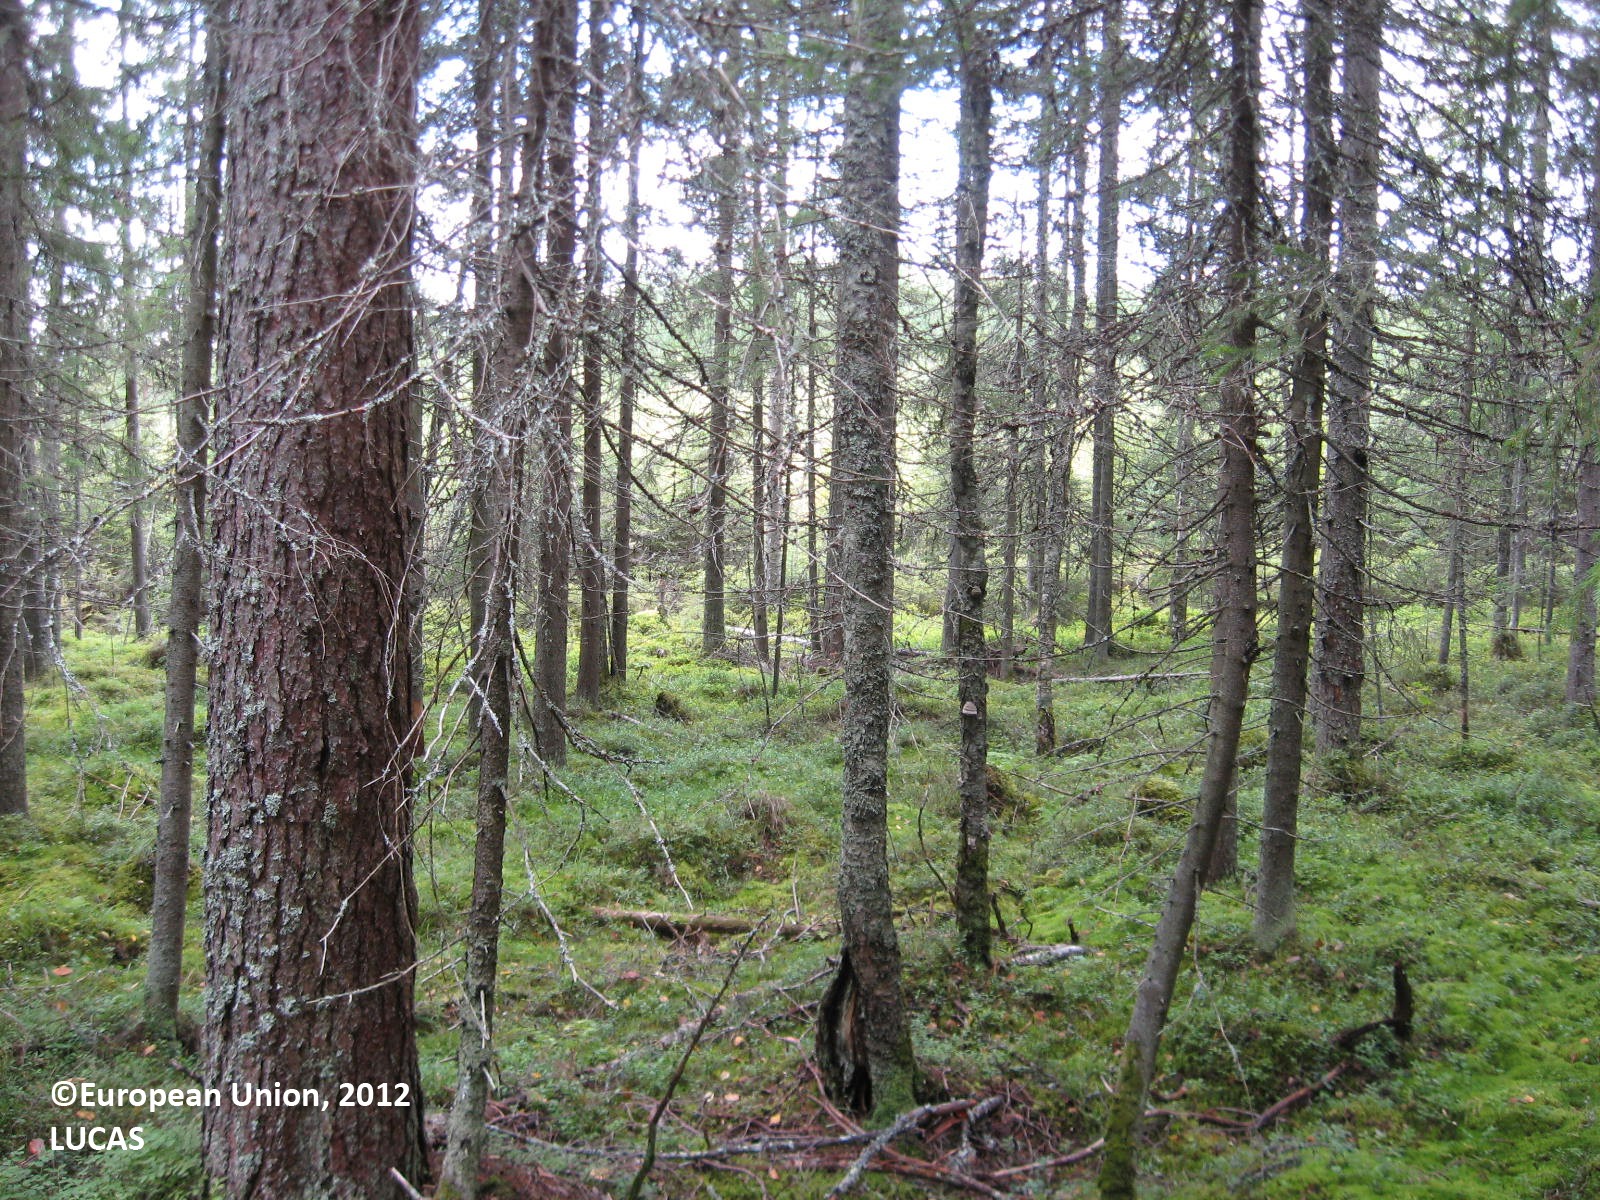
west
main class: Woodland
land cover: Spruce dominated coniferous woodland
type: boreal forest
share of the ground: > 75 %
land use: Forestry
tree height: > 5 m
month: August
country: FI
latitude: 63.6016
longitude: 30.1925
